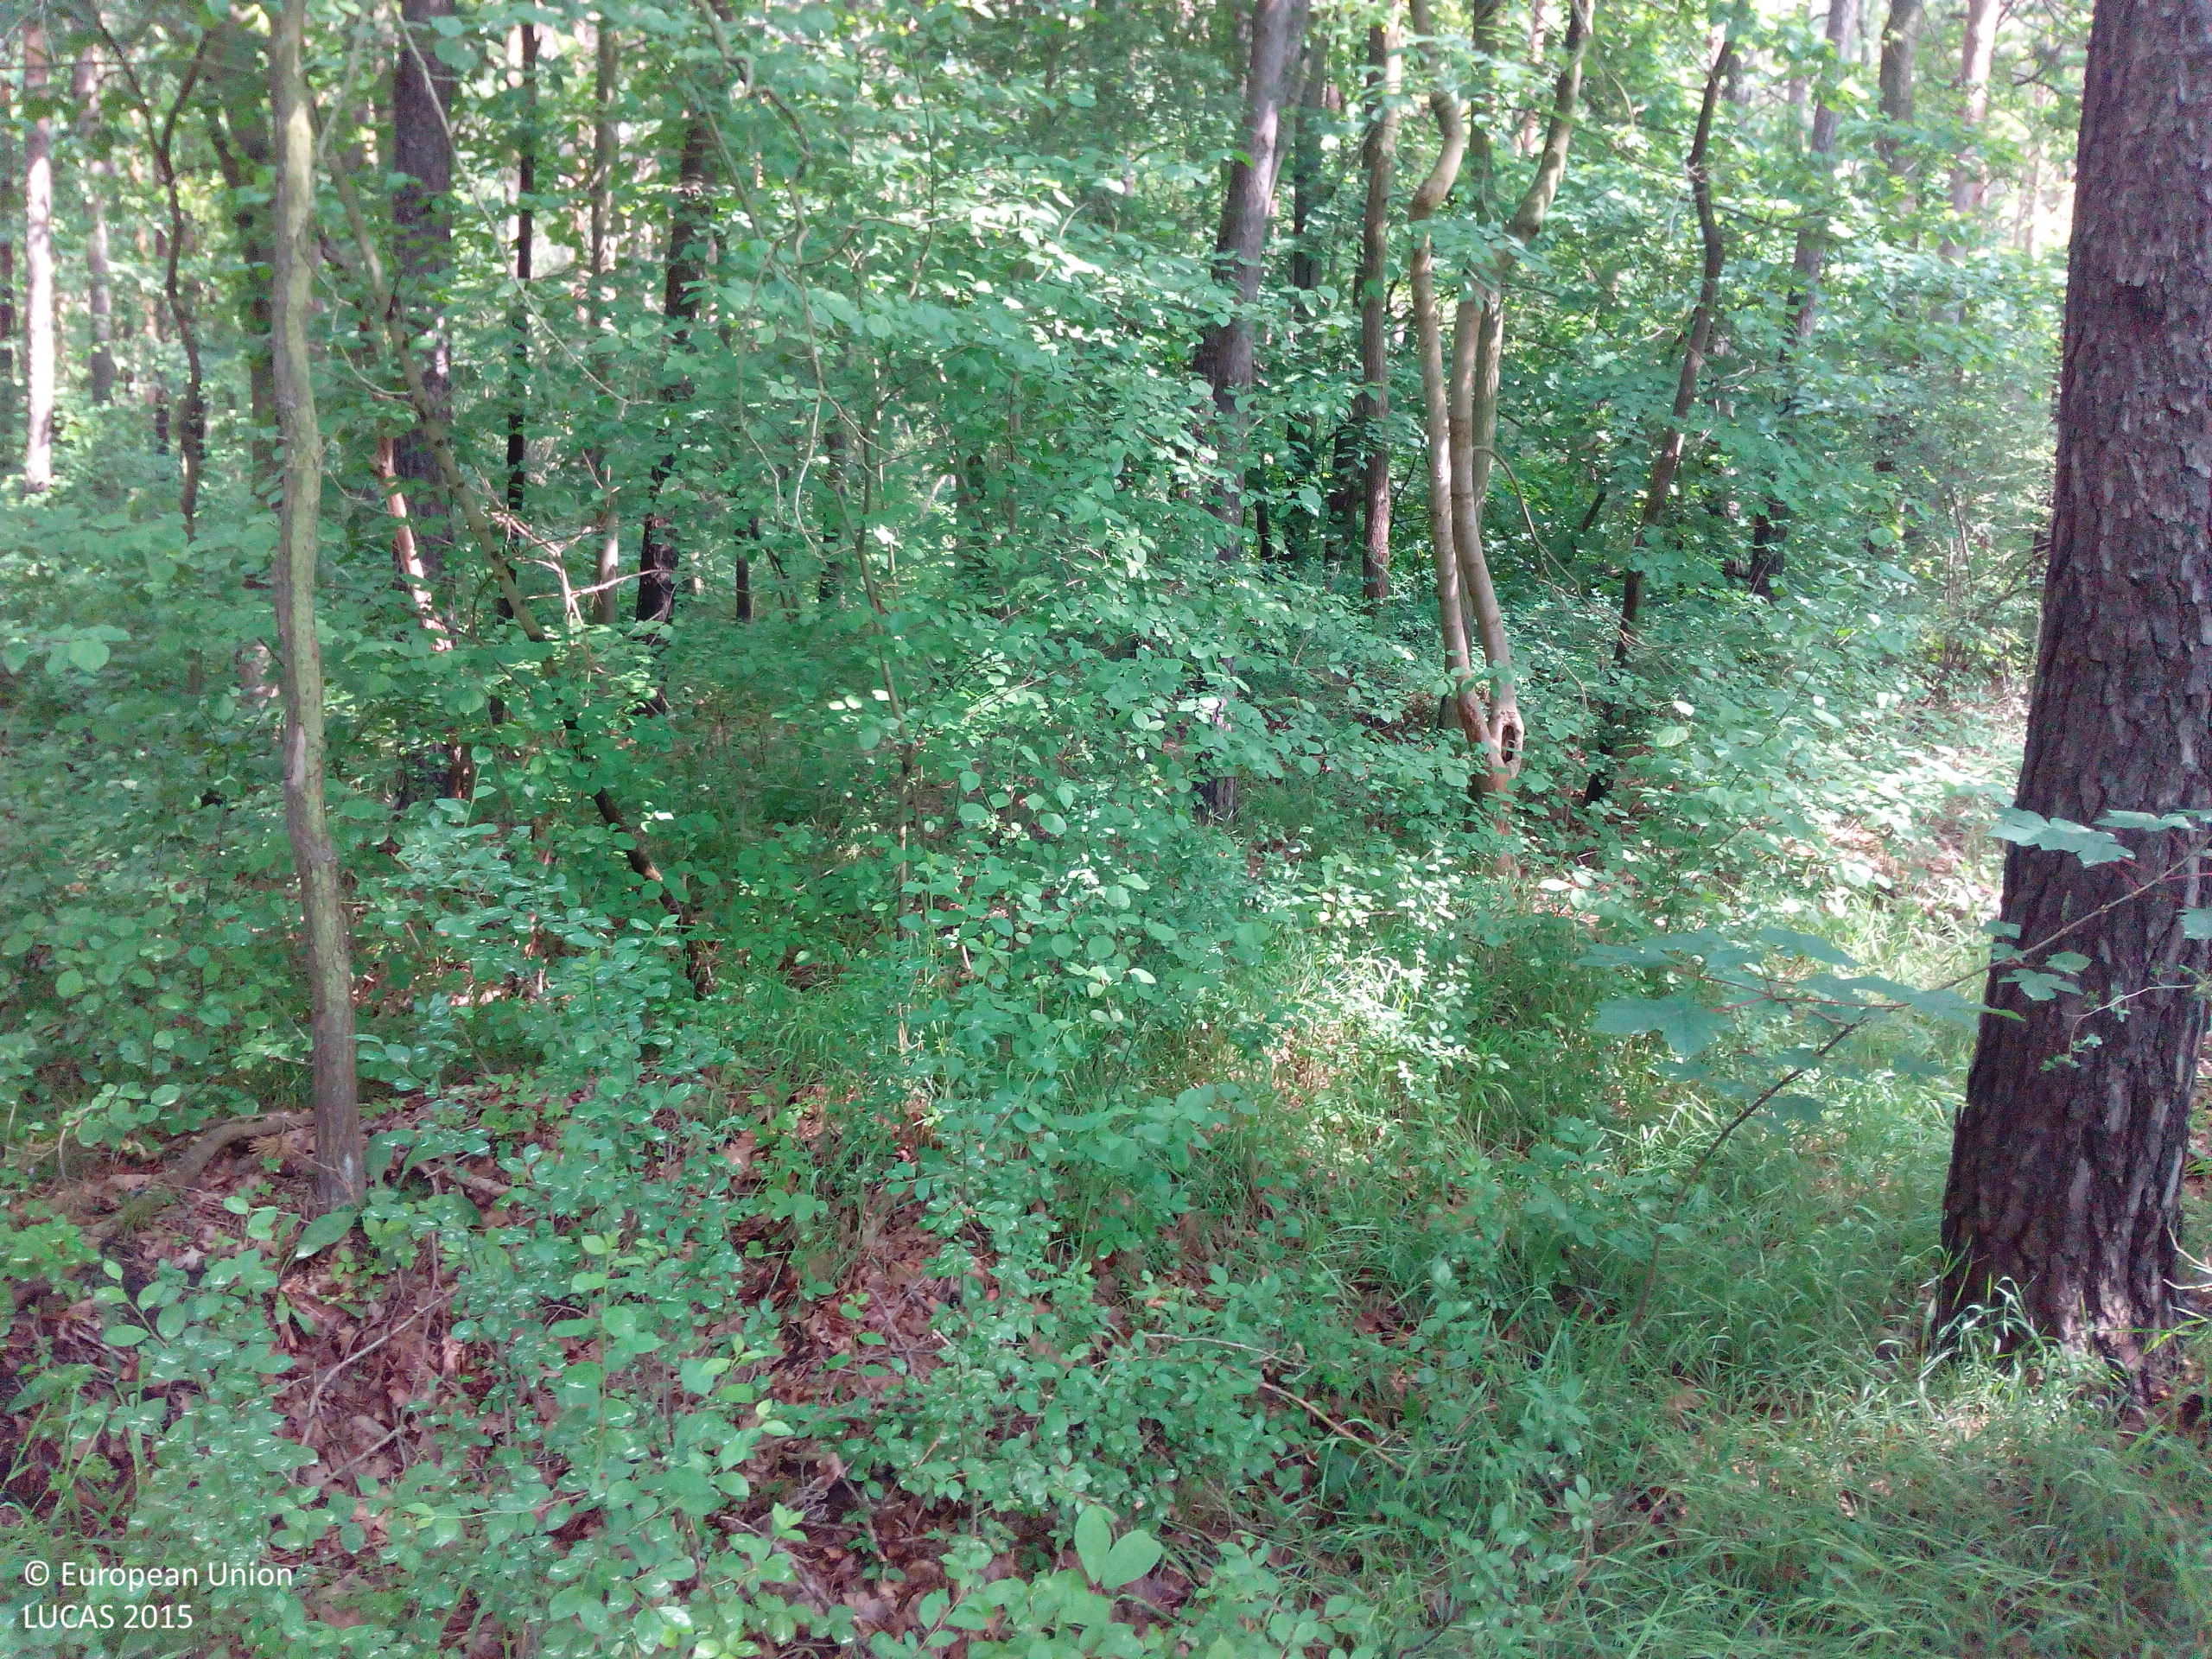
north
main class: Woodland
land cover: Pine dominated mixed woodland
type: hemiboreal forest and nemoral coniferous forest and mixed broadleaved-coniferous forest
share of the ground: > 75 %
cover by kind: coniferous forest trees 55 %, broadleaved forest trees 40 %, shrubs 5 %
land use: Forestry
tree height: > 5 m
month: May
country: DE
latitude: 51.6882
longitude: 12.3865
